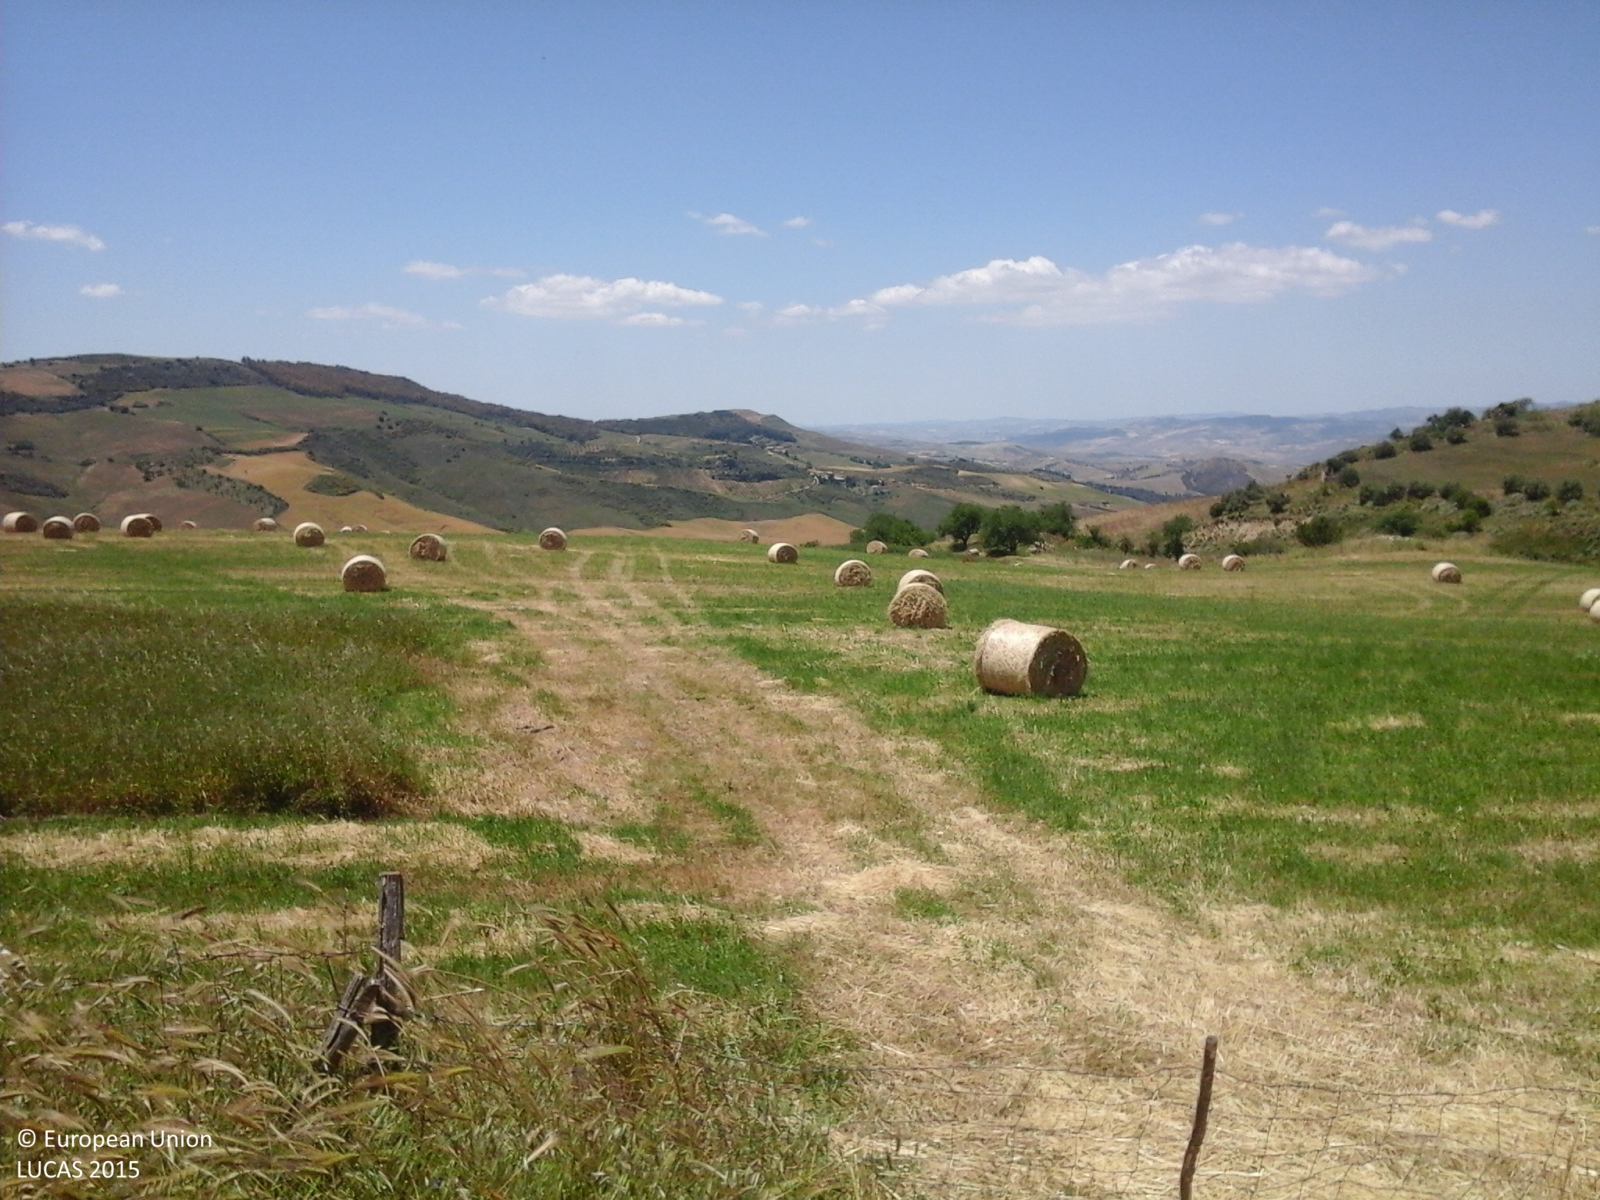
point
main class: Grassland
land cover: Grassland without tree/shrub cover
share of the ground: > 75 %
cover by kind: herbaceous plants 100 %
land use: Agriculture (excluding fallow land and kitchen gardens)
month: May
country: IT
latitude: 37.4877
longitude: 14.2772
